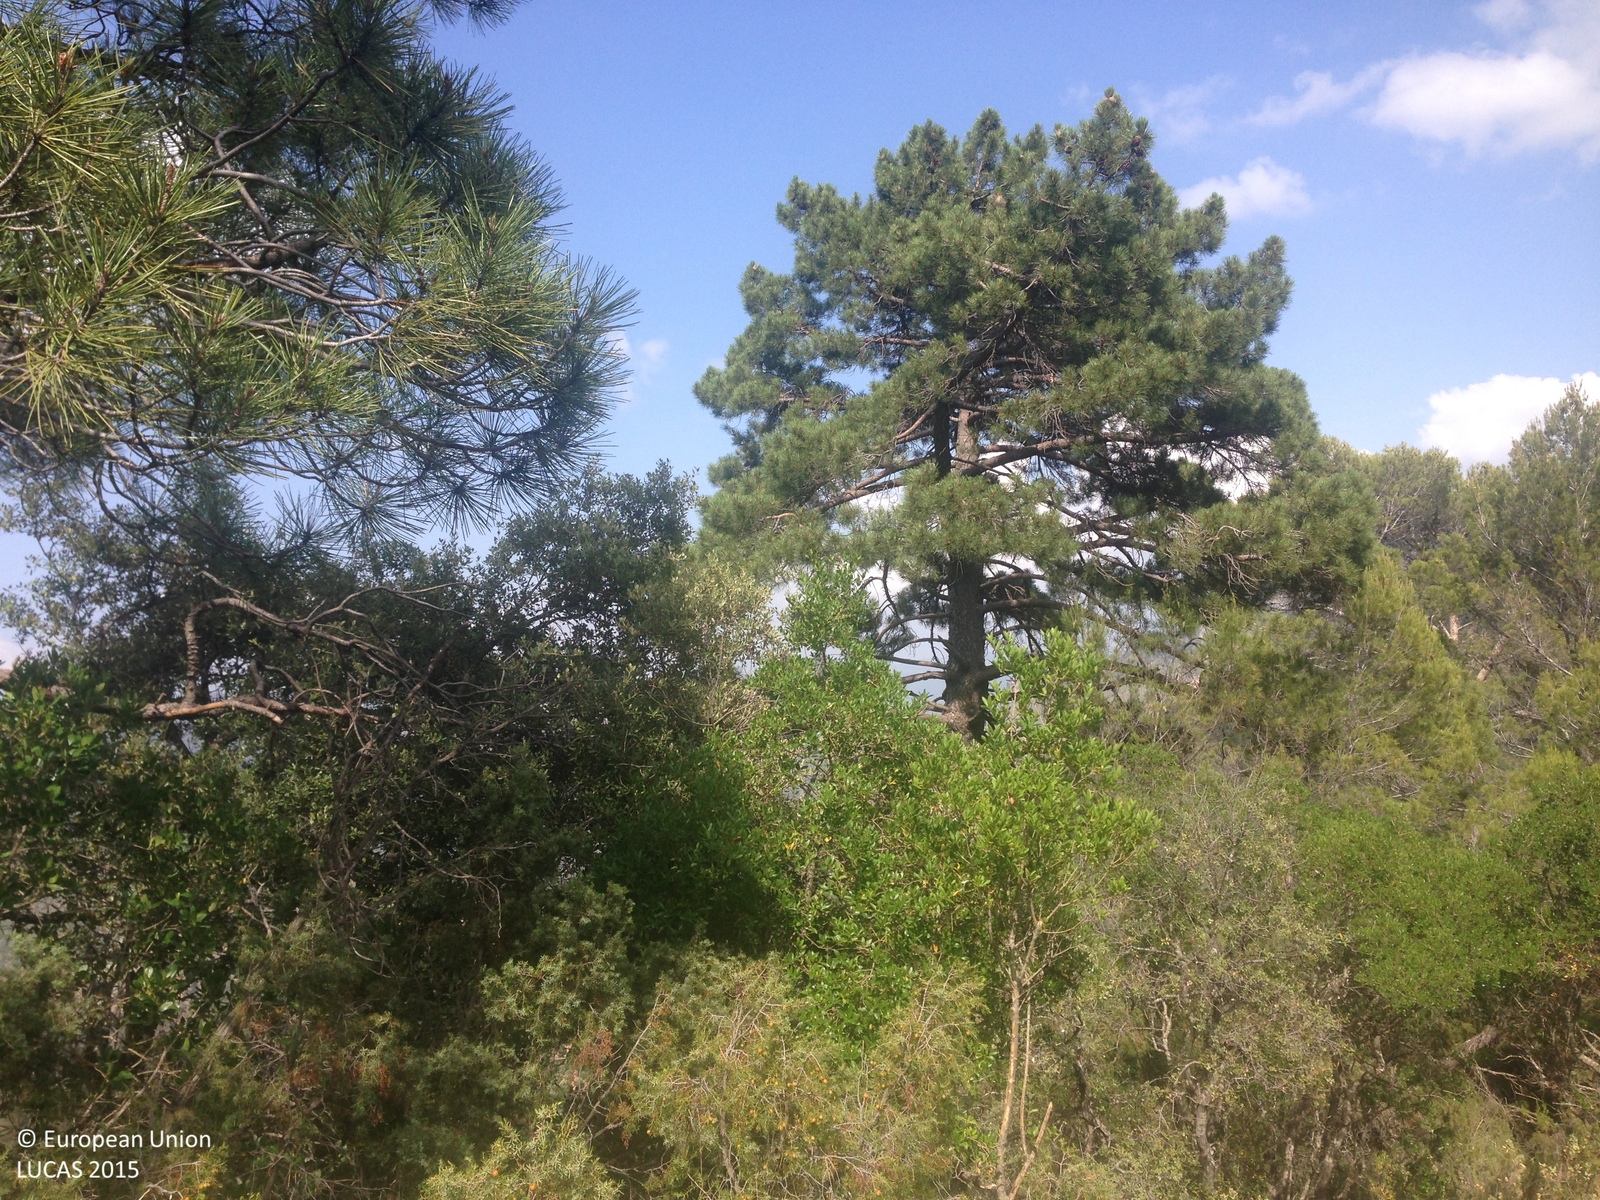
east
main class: Woodland
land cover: Pine dominated coniferous woodland
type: coniferous forest of the mediterranean region
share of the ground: 50 - 75 %
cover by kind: coniferous forest trees 60 %, shrubs 30 %, unconsolidated bare surface 10 %
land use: Forestry
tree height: > 5 m
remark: Clear cut
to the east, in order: Pine dominated coniferous woodland; Shrubland with sparse tree cover; Pine dominated coniferous woodland; Grassland with sparse tree/shrub cover; Pine dominated coniferous woodland; Shrubland with sparse tree cover
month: June
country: ES
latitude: 38.1718
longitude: -2.8620
